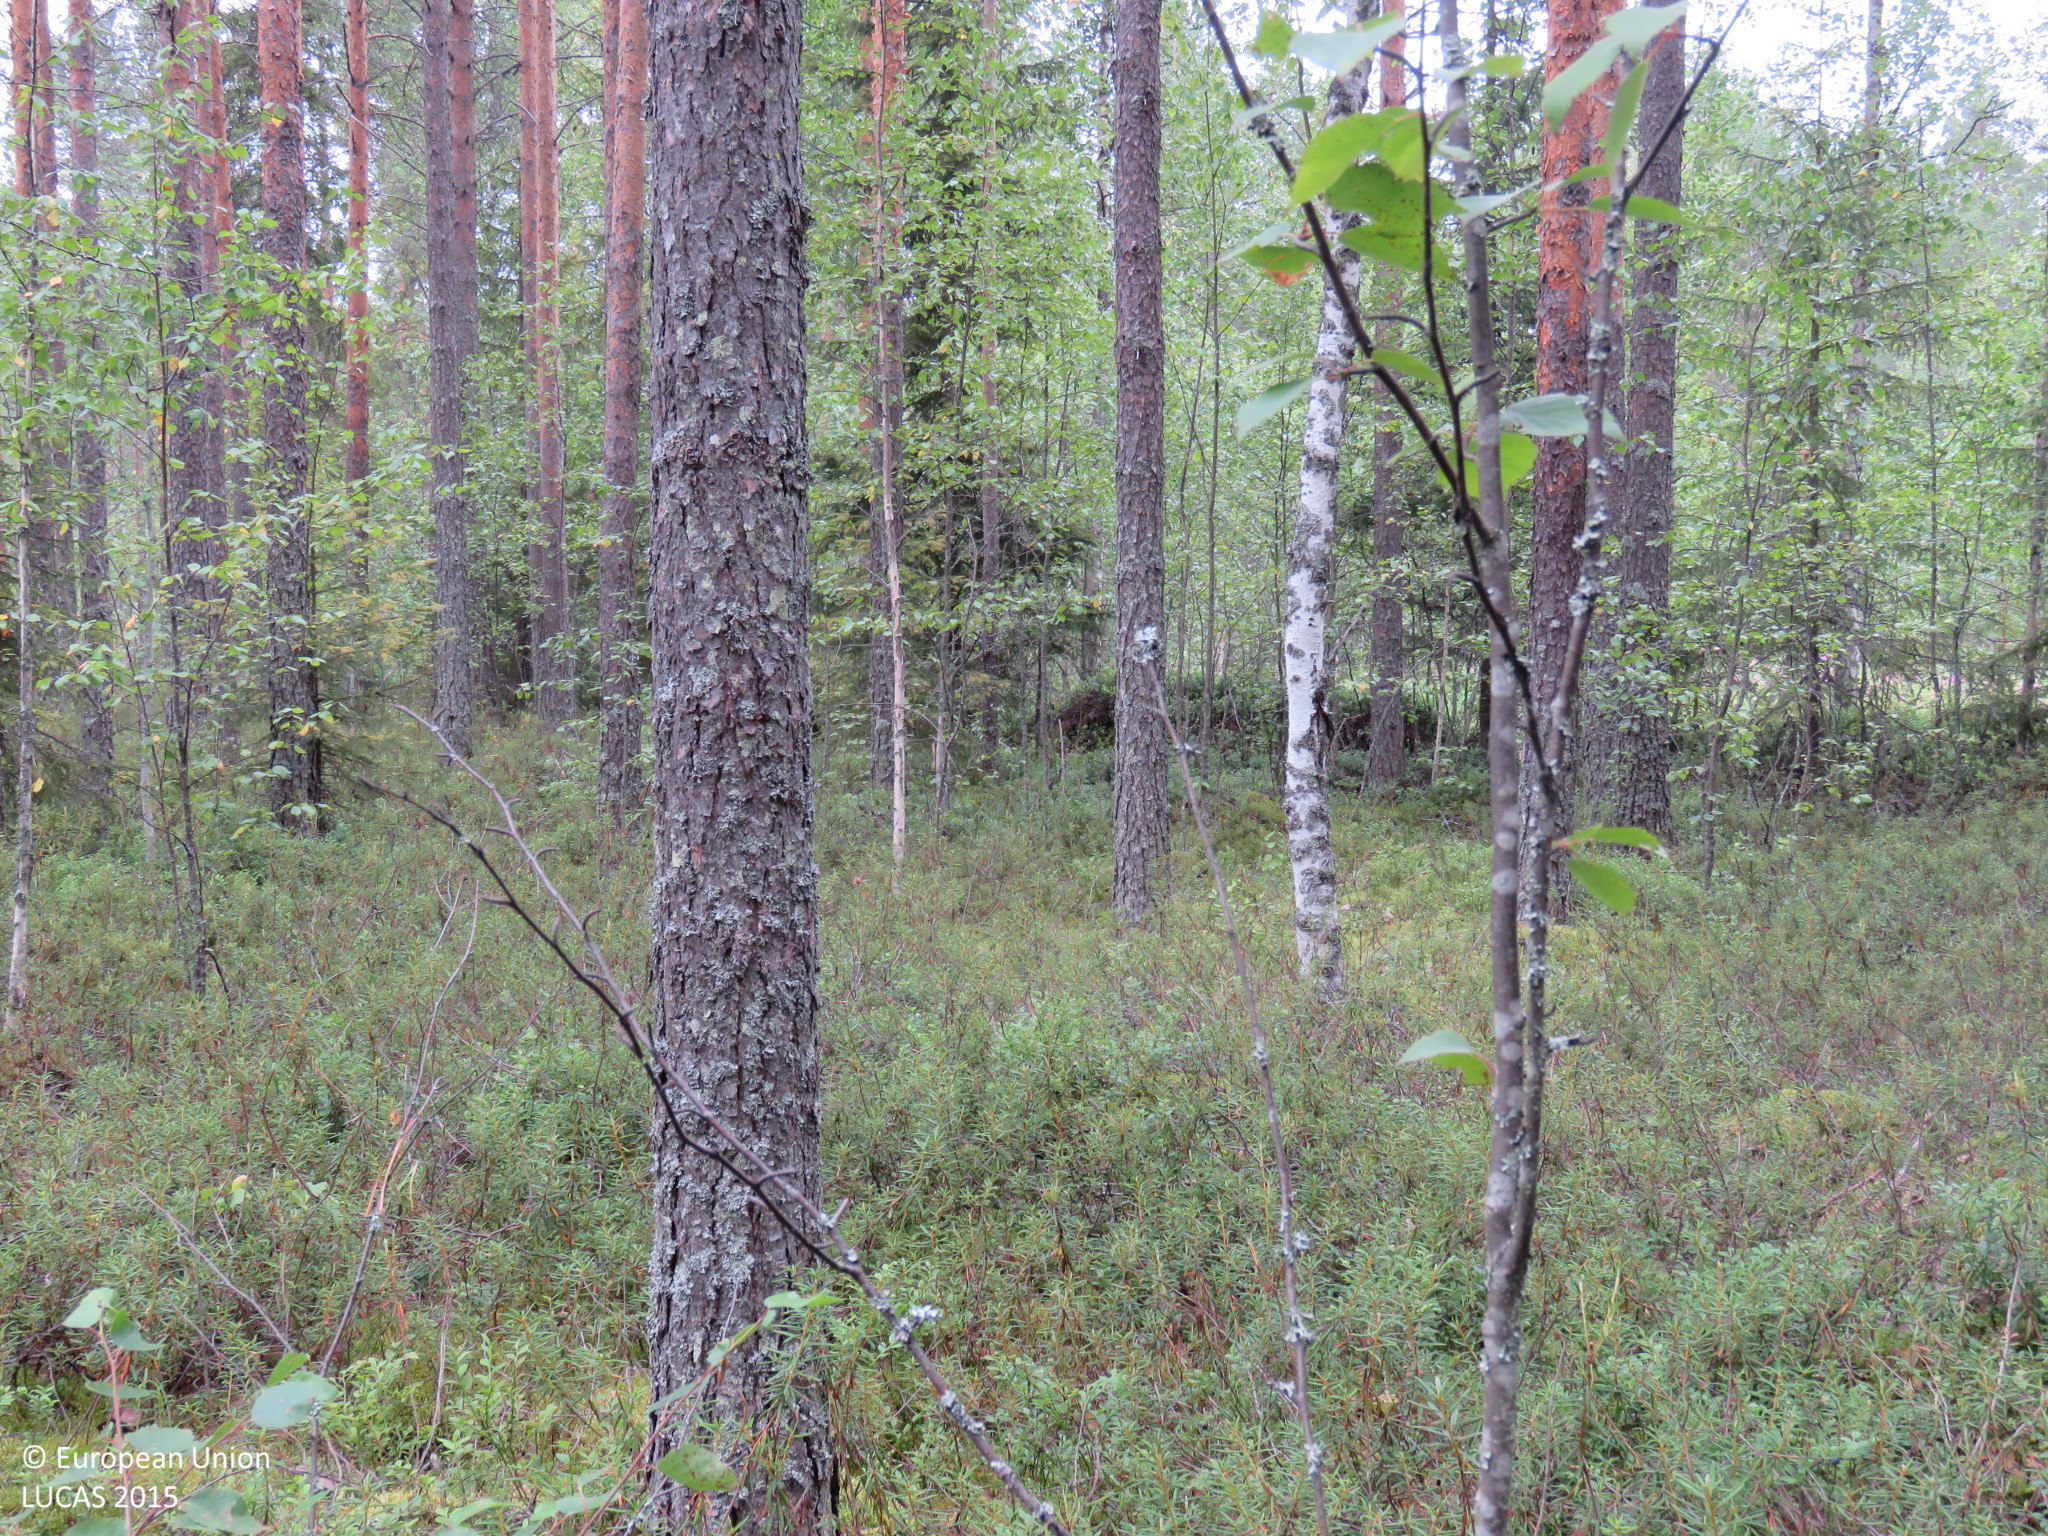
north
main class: Woodland
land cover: Other coniferous woodland
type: boreal forest
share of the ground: > 75 %
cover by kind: coniferous forest trees 65 %, shrubs 20 %, broadleaved forest trees 15 %
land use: Forestry
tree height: > 5 m
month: July
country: FI
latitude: 64.6040
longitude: 26.6474
